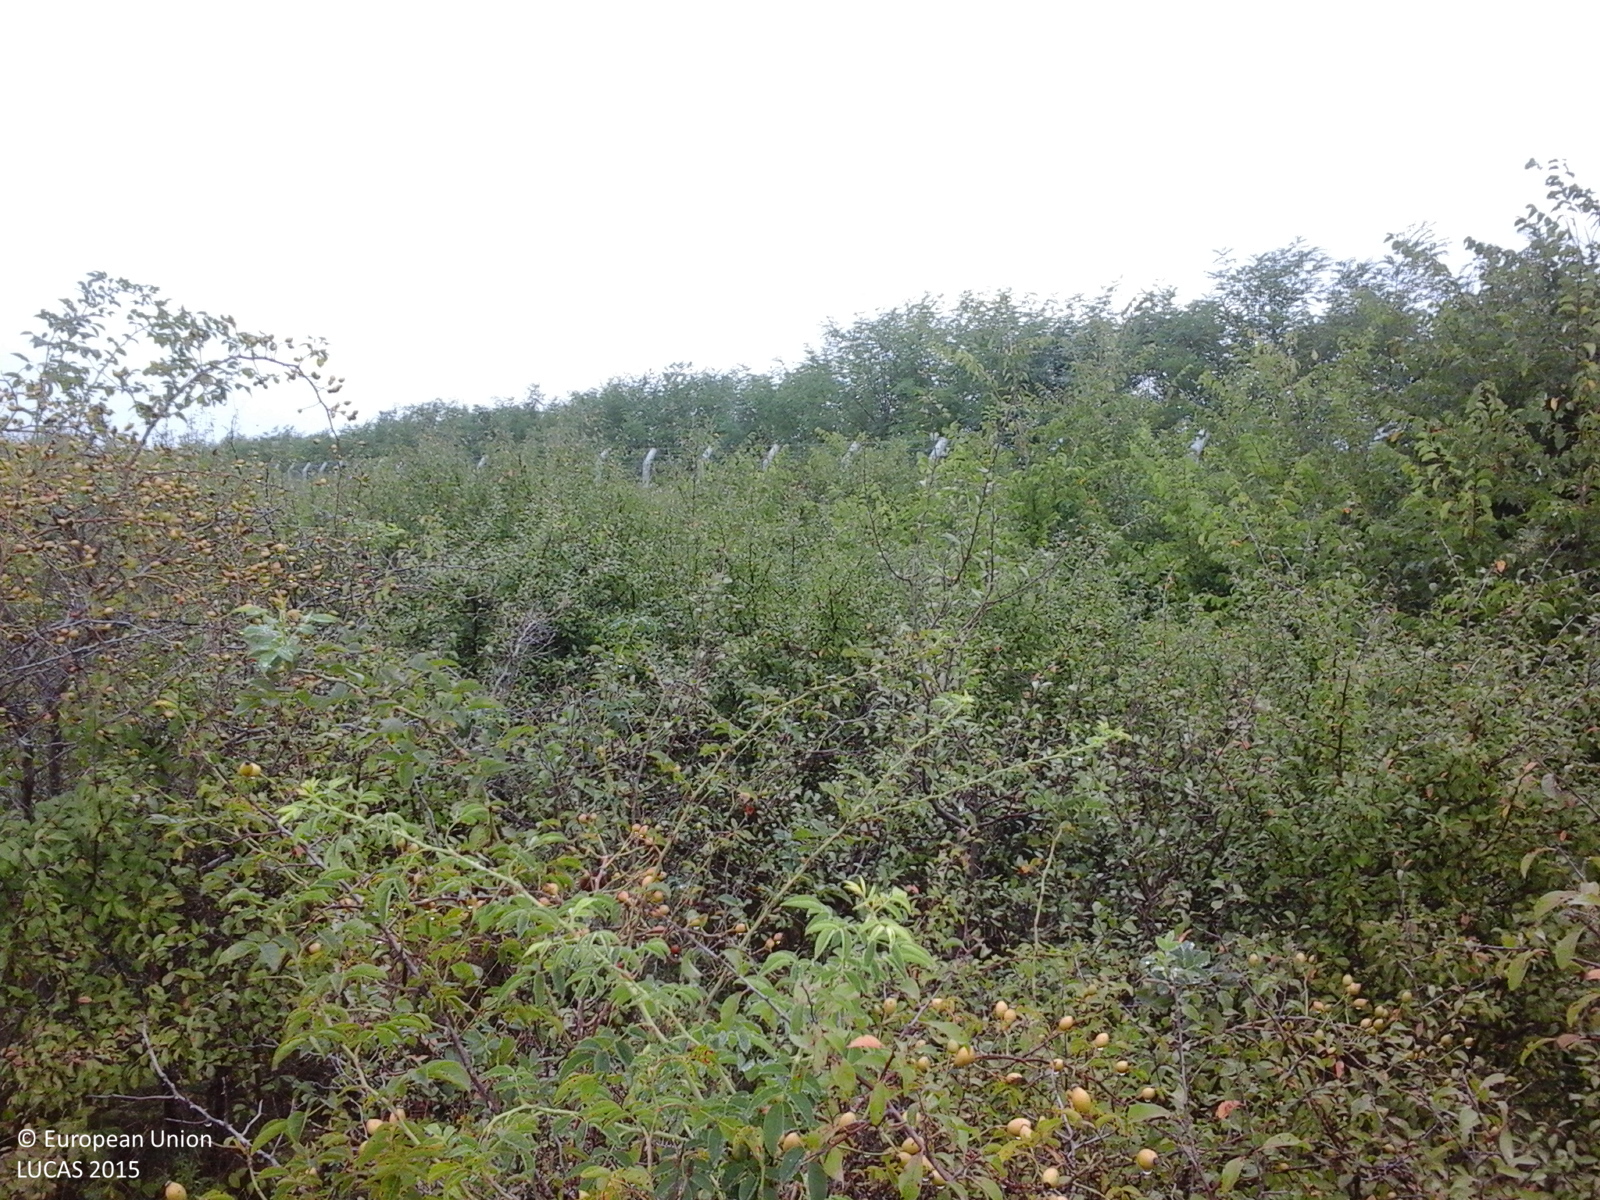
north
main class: Shrubland
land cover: Shrubland with sparse tree cover
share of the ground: > 75 %
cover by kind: shrubs 90 %, broadleaved forest trees 5 %, herbaceous plants 5 %
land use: Semi-natural and natural areas not in use
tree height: < 5 m
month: August
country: RO
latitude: 45.7914
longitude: 21.7564
